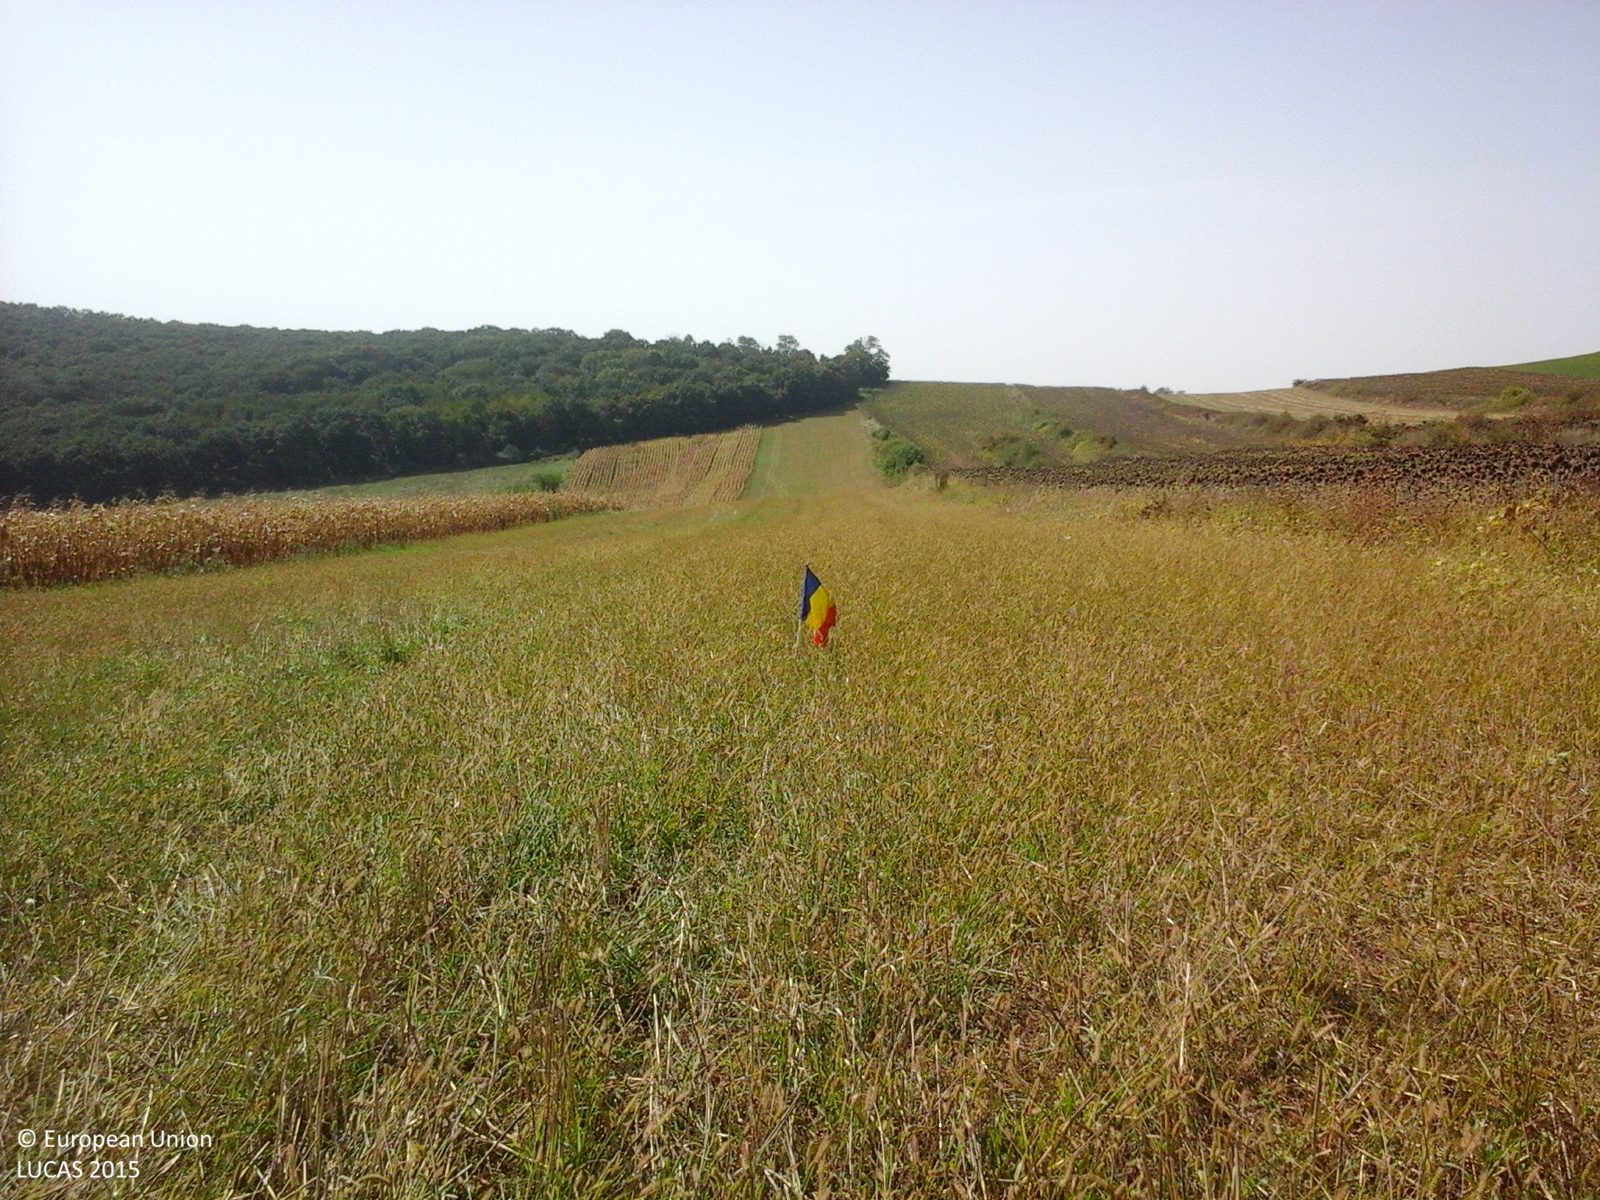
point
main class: Grassland
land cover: Grassland without tree/shrub cover
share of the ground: > 75 %
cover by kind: herbaceous plants 100 %
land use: Agriculture (excluding fallow land and kitchen gardens)
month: September
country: RO
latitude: 46.7420
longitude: 24.1247
